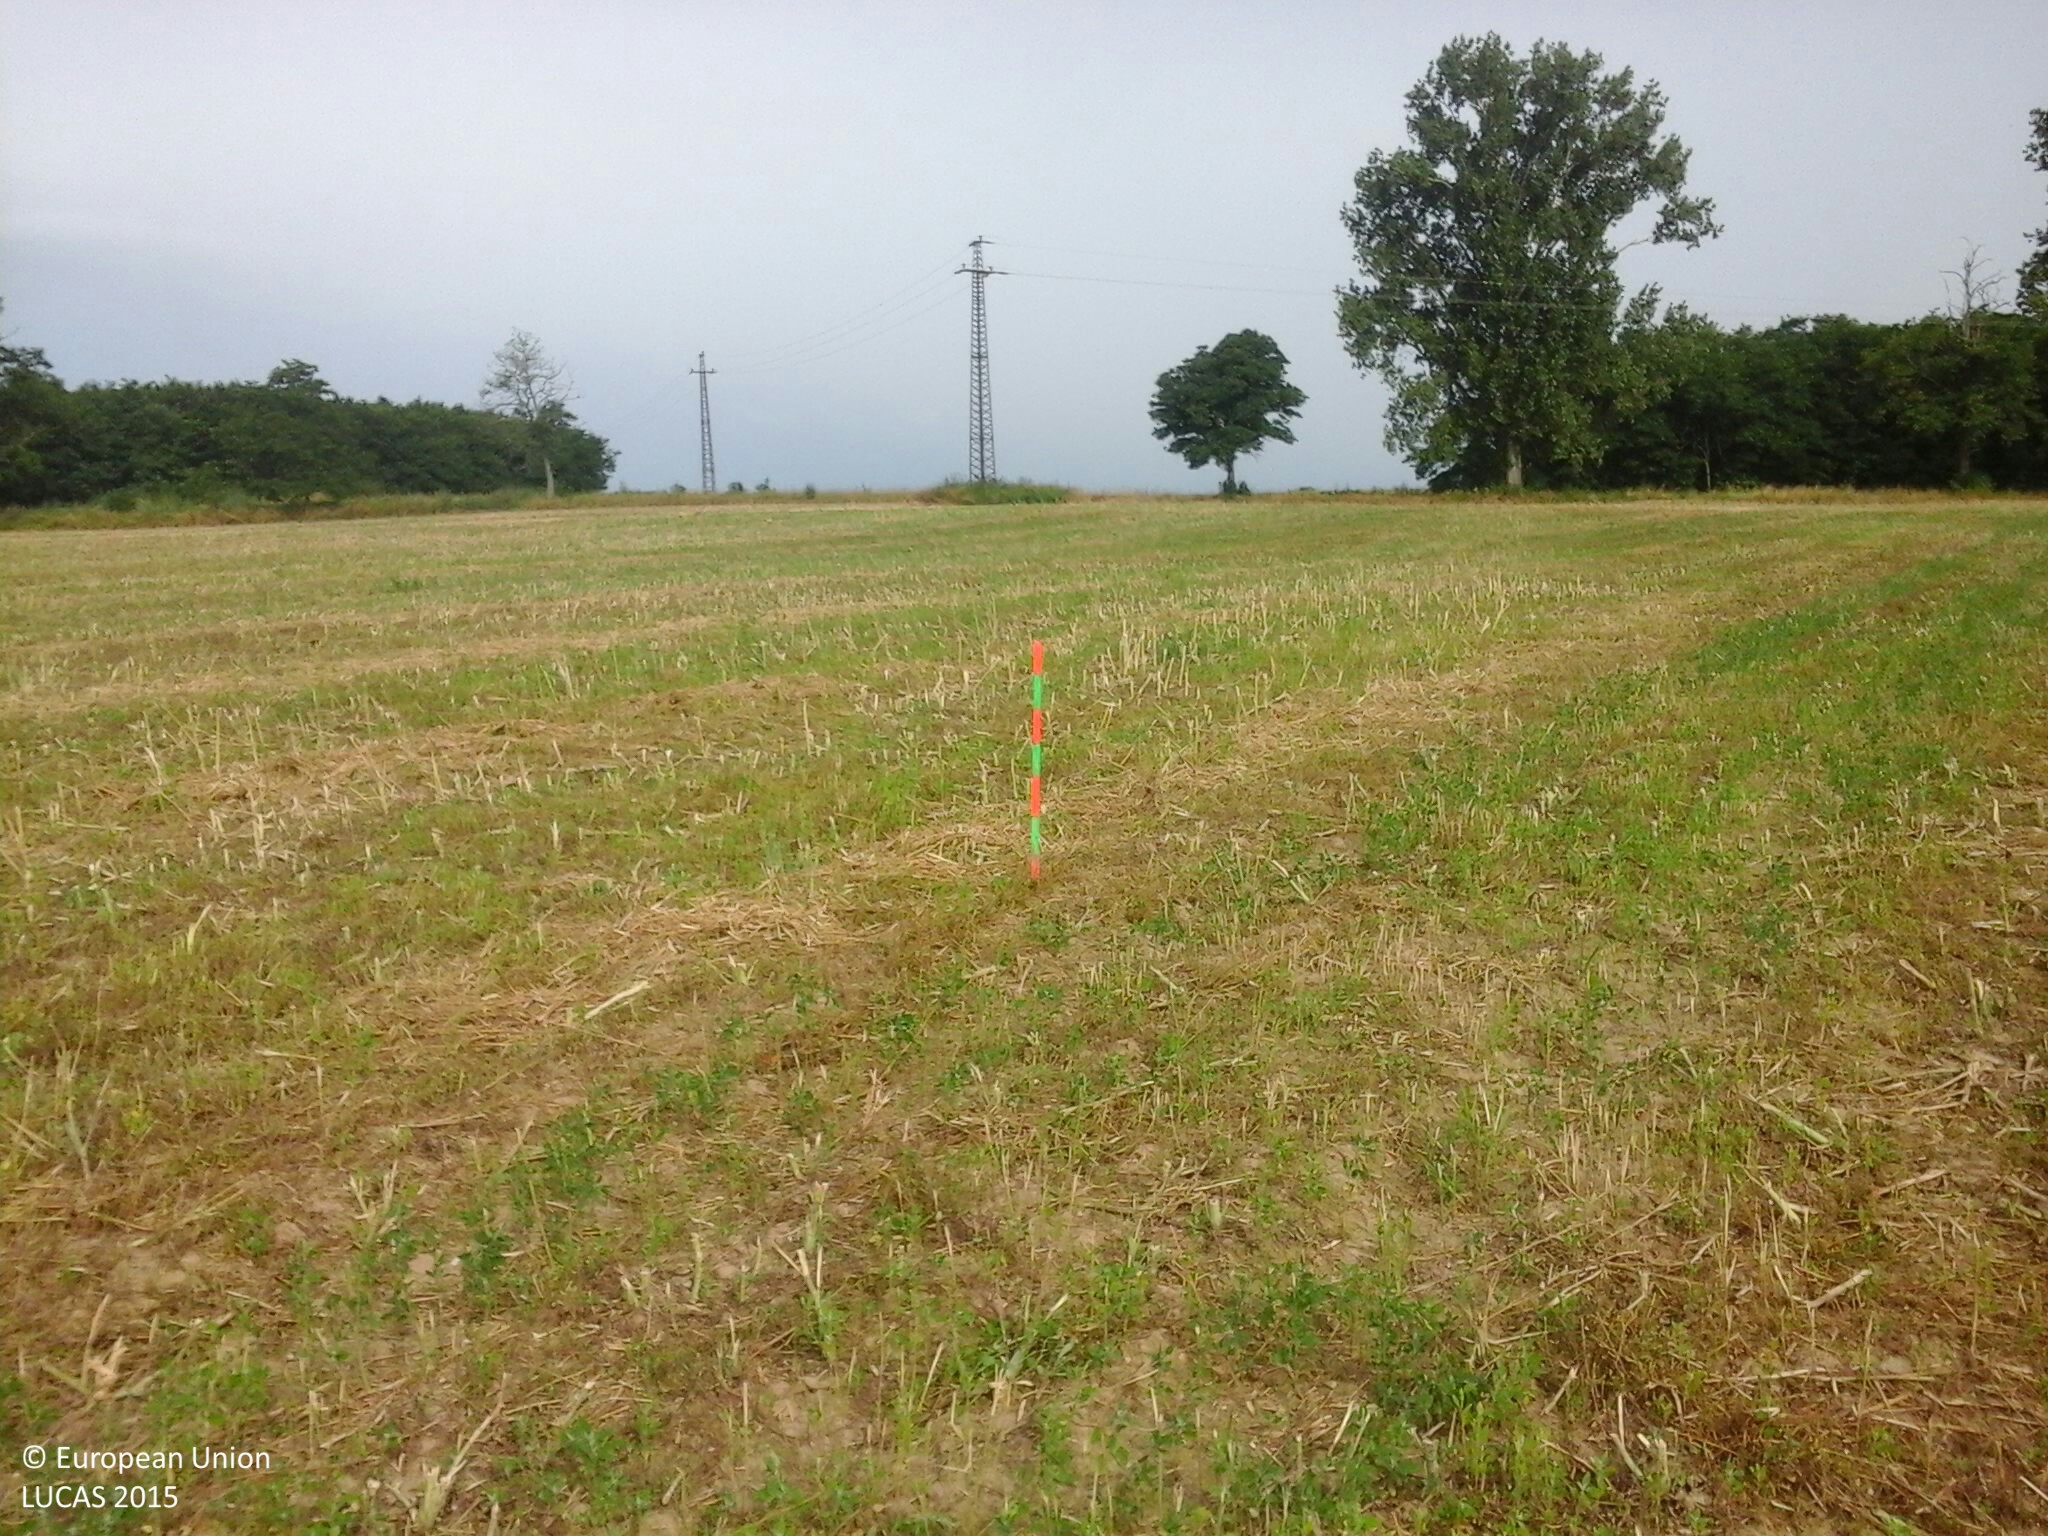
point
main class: Cropland
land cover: Rape and turnip rape
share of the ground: 10 - 25 %
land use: Agriculture (excluding fallow land and kitchen gardens)
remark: Harvested field
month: July
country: HU
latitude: 47.1860
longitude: 17.3041
